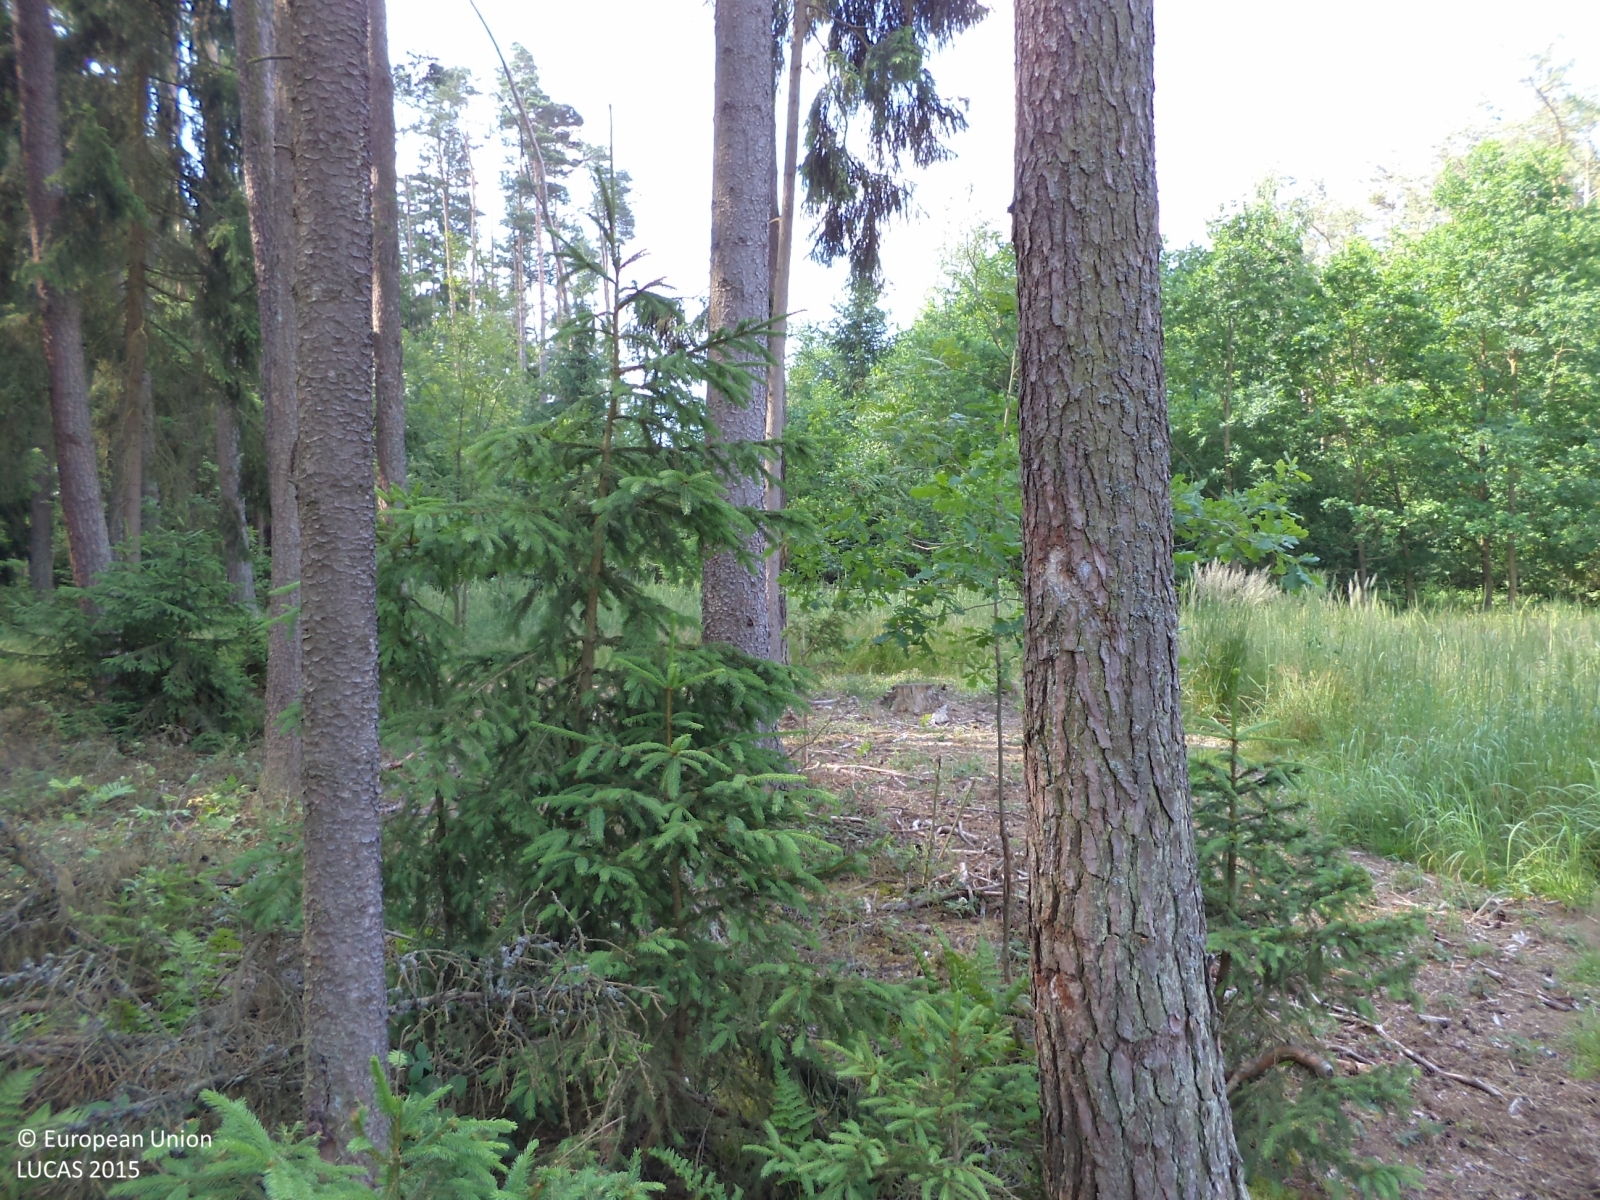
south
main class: Woodland
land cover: Pine dominated coniferous woodland
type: hemiboreal forest and nemoral coniferous forest and mixed broadleaved-coniferous forest
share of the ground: > 75 %
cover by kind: coniferous forest trees 90 %, herbaceous plants 10 %
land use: Forestry
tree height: > 5 m
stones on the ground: < 10 %
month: July
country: CZ
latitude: 49.3780
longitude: 14.4226
